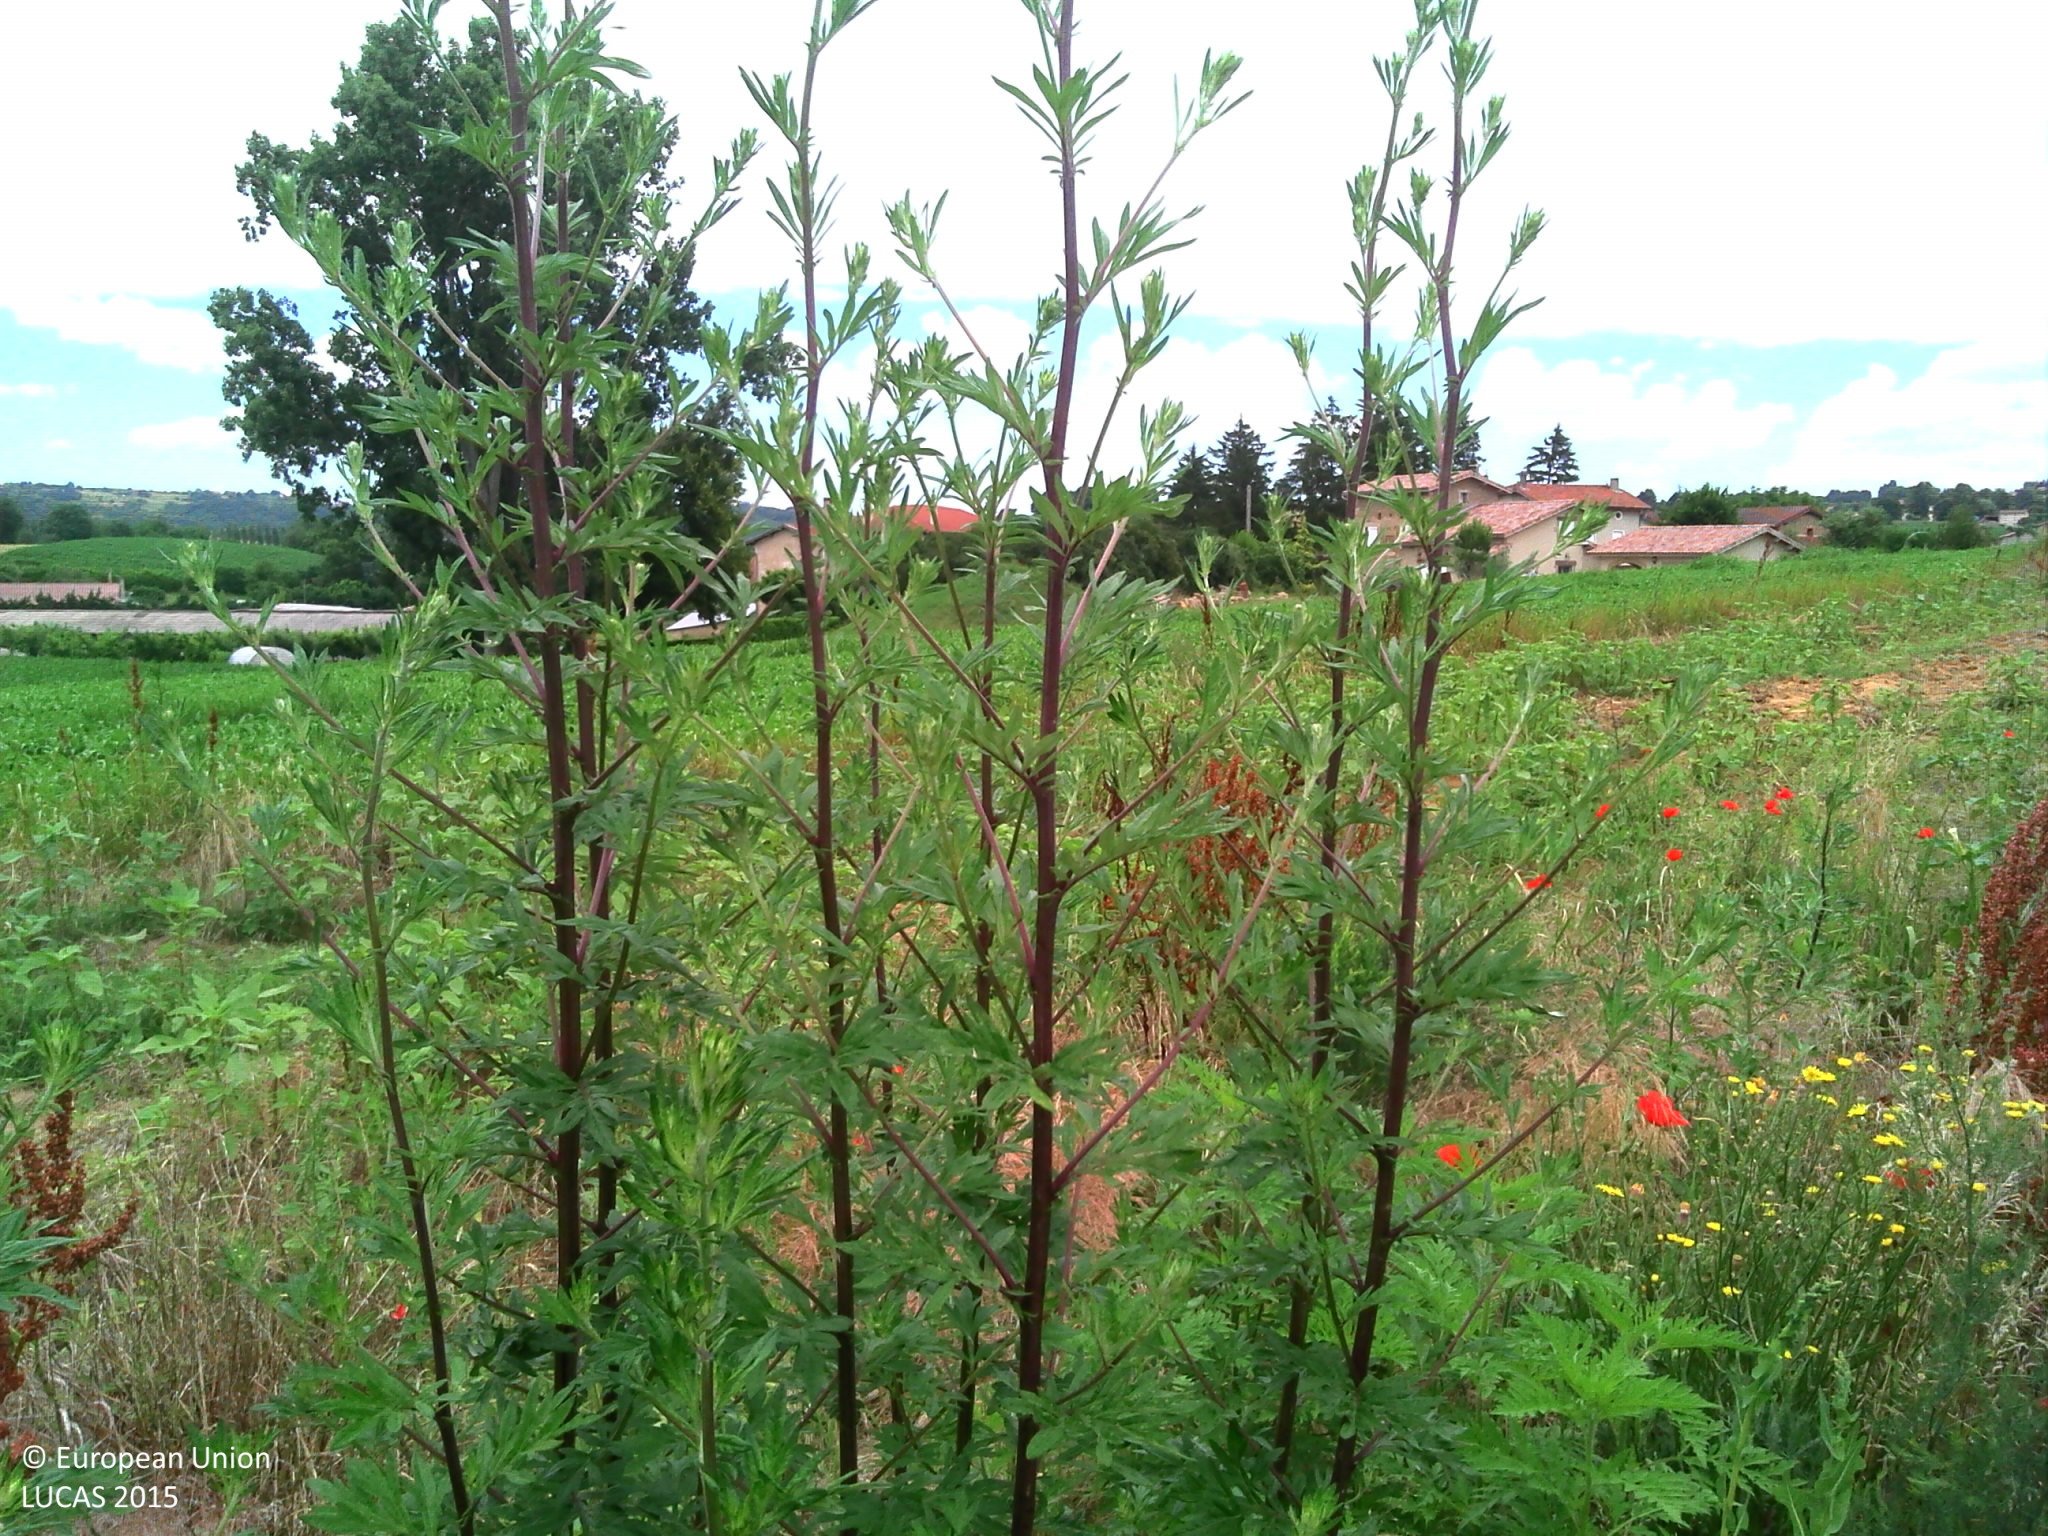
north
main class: Grassland
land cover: Spontaneously vegetated surfaces
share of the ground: > 75 %
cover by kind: herbaceous plants 100 %
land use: Agriculture (excluding fallow land and kitchen gardens)
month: June
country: FR
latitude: 45.1348
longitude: 5.0334
